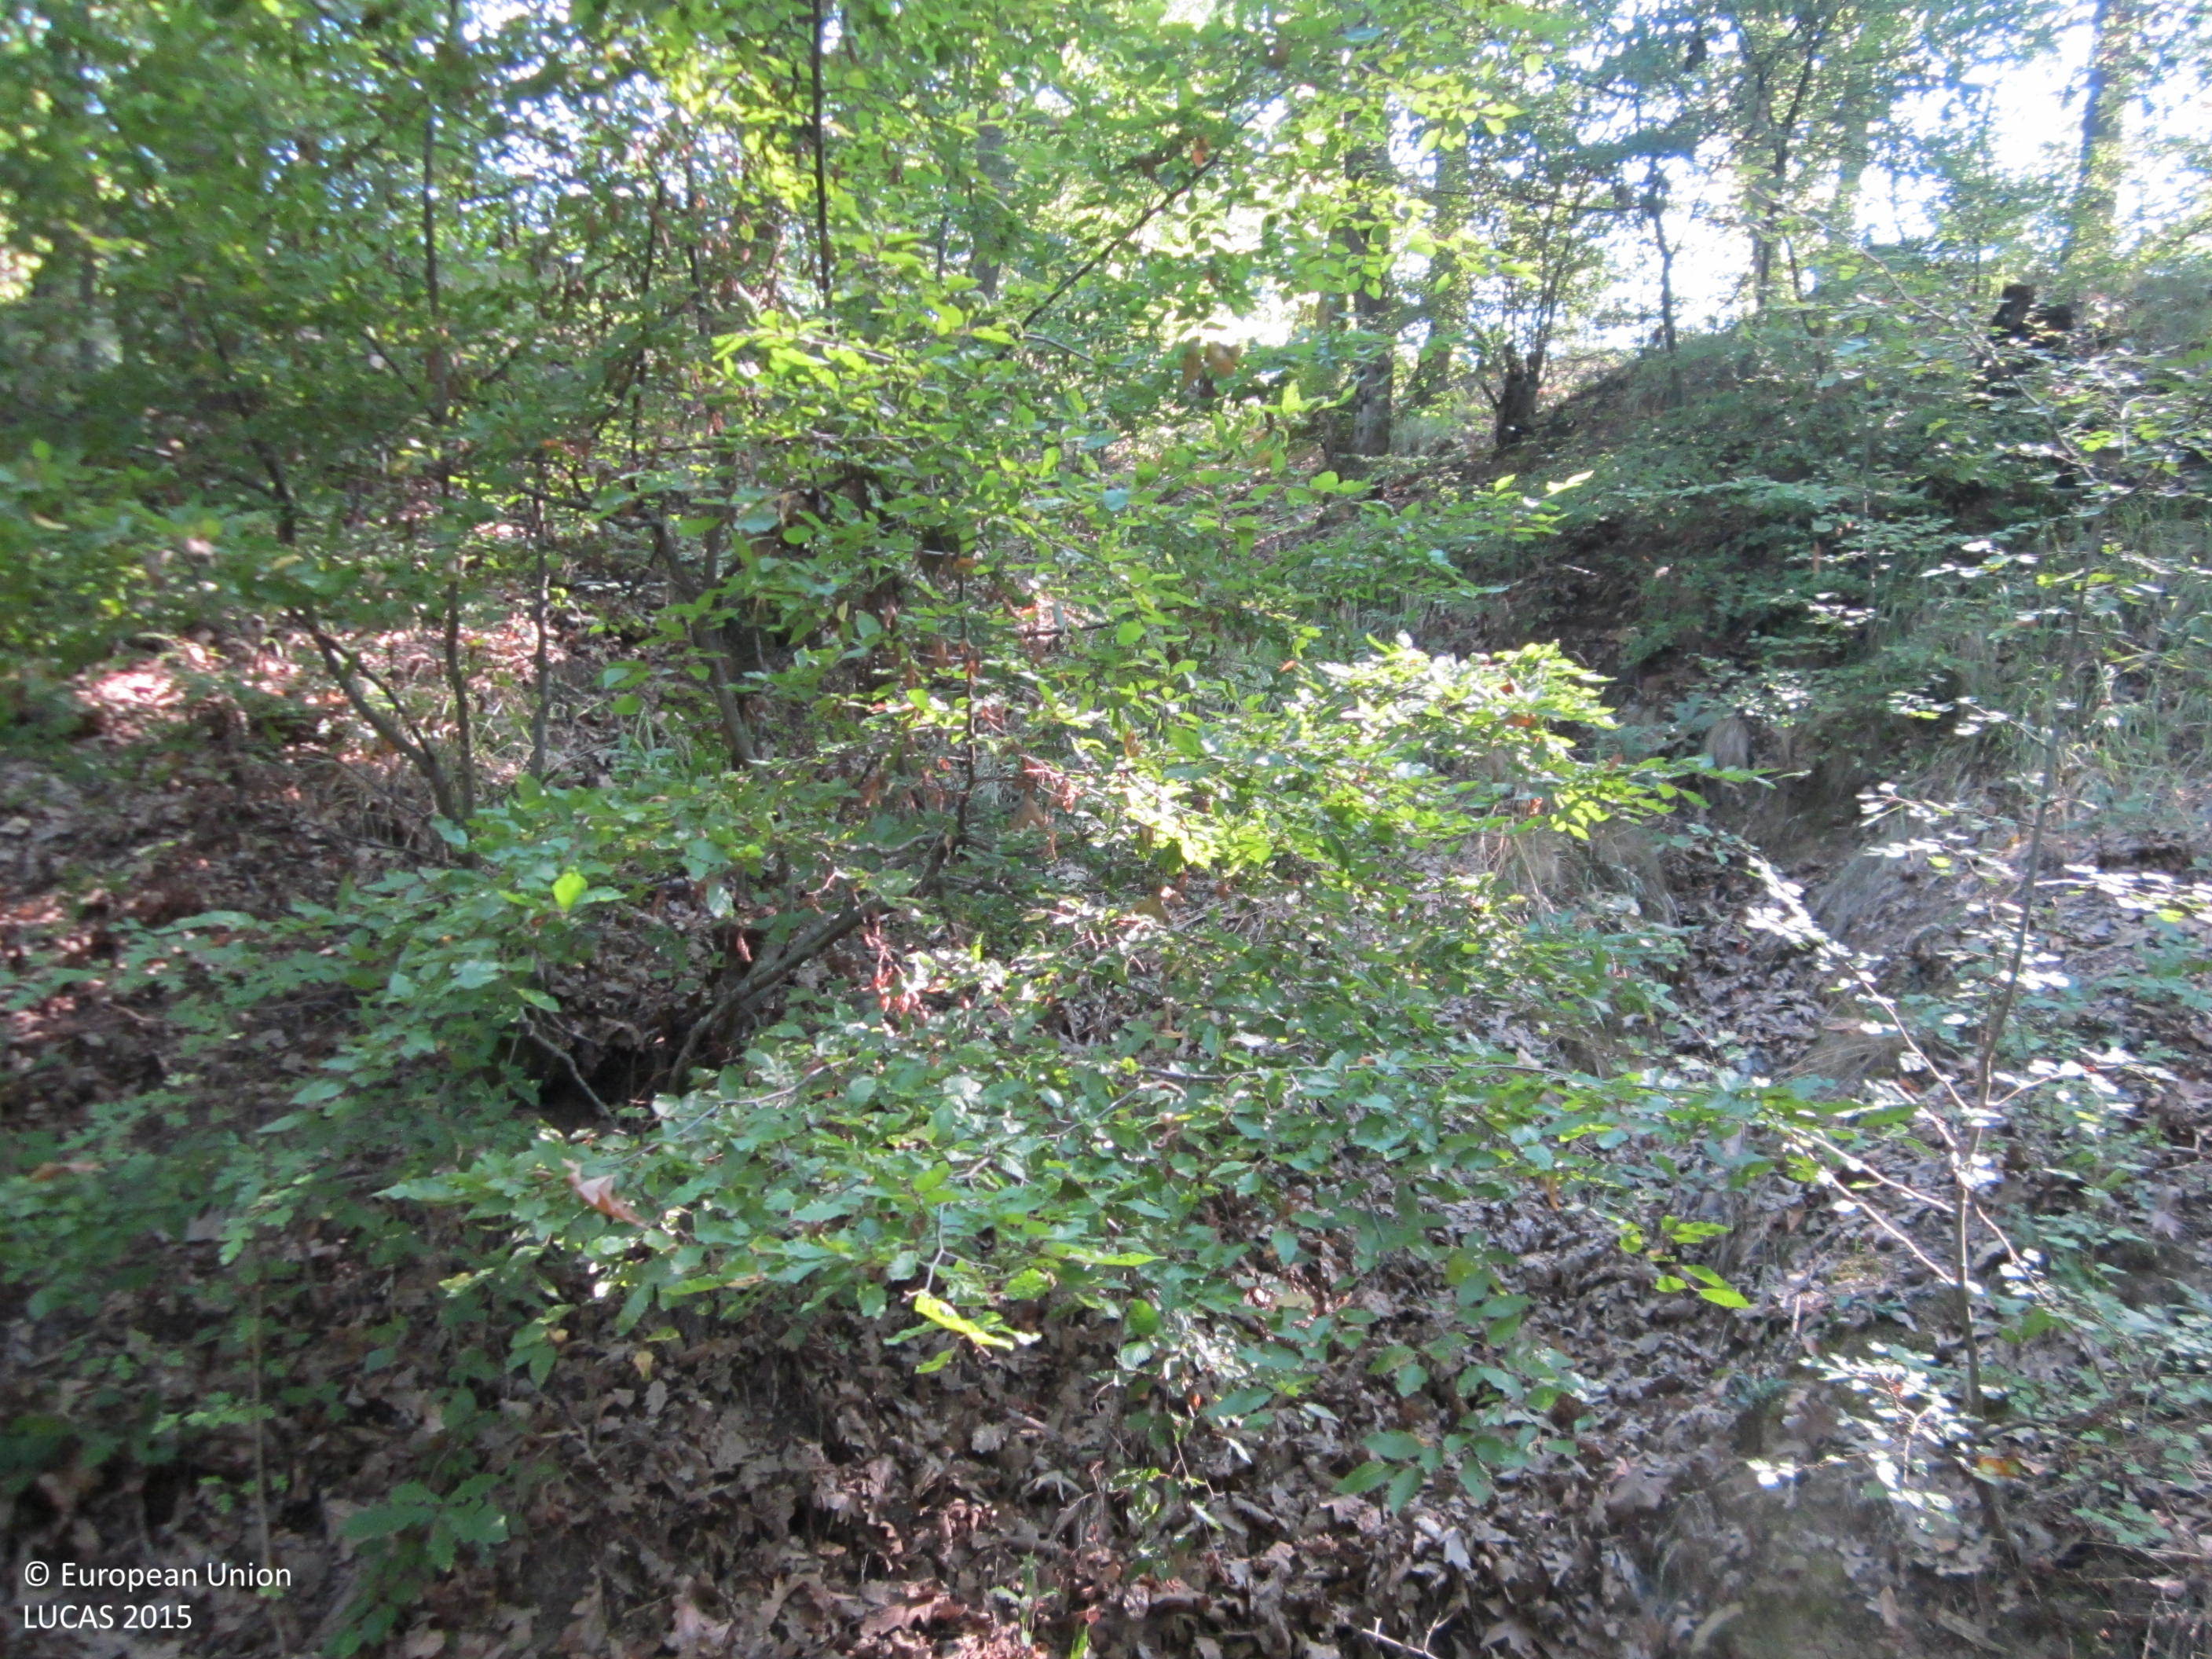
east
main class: Woodland
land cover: Broadleaved woodland
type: mesophytic deciduous forest
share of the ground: > 75 %
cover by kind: broadleaved forest trees 95 %, unconsolidated bare surface 5 %
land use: Forestry
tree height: > 5 m
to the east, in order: Broadleaved woodland; Shrubland with sparse tree cover; Tracks; Grass margins; Vineyards
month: September
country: BG
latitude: 42.8407
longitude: 26.9056
